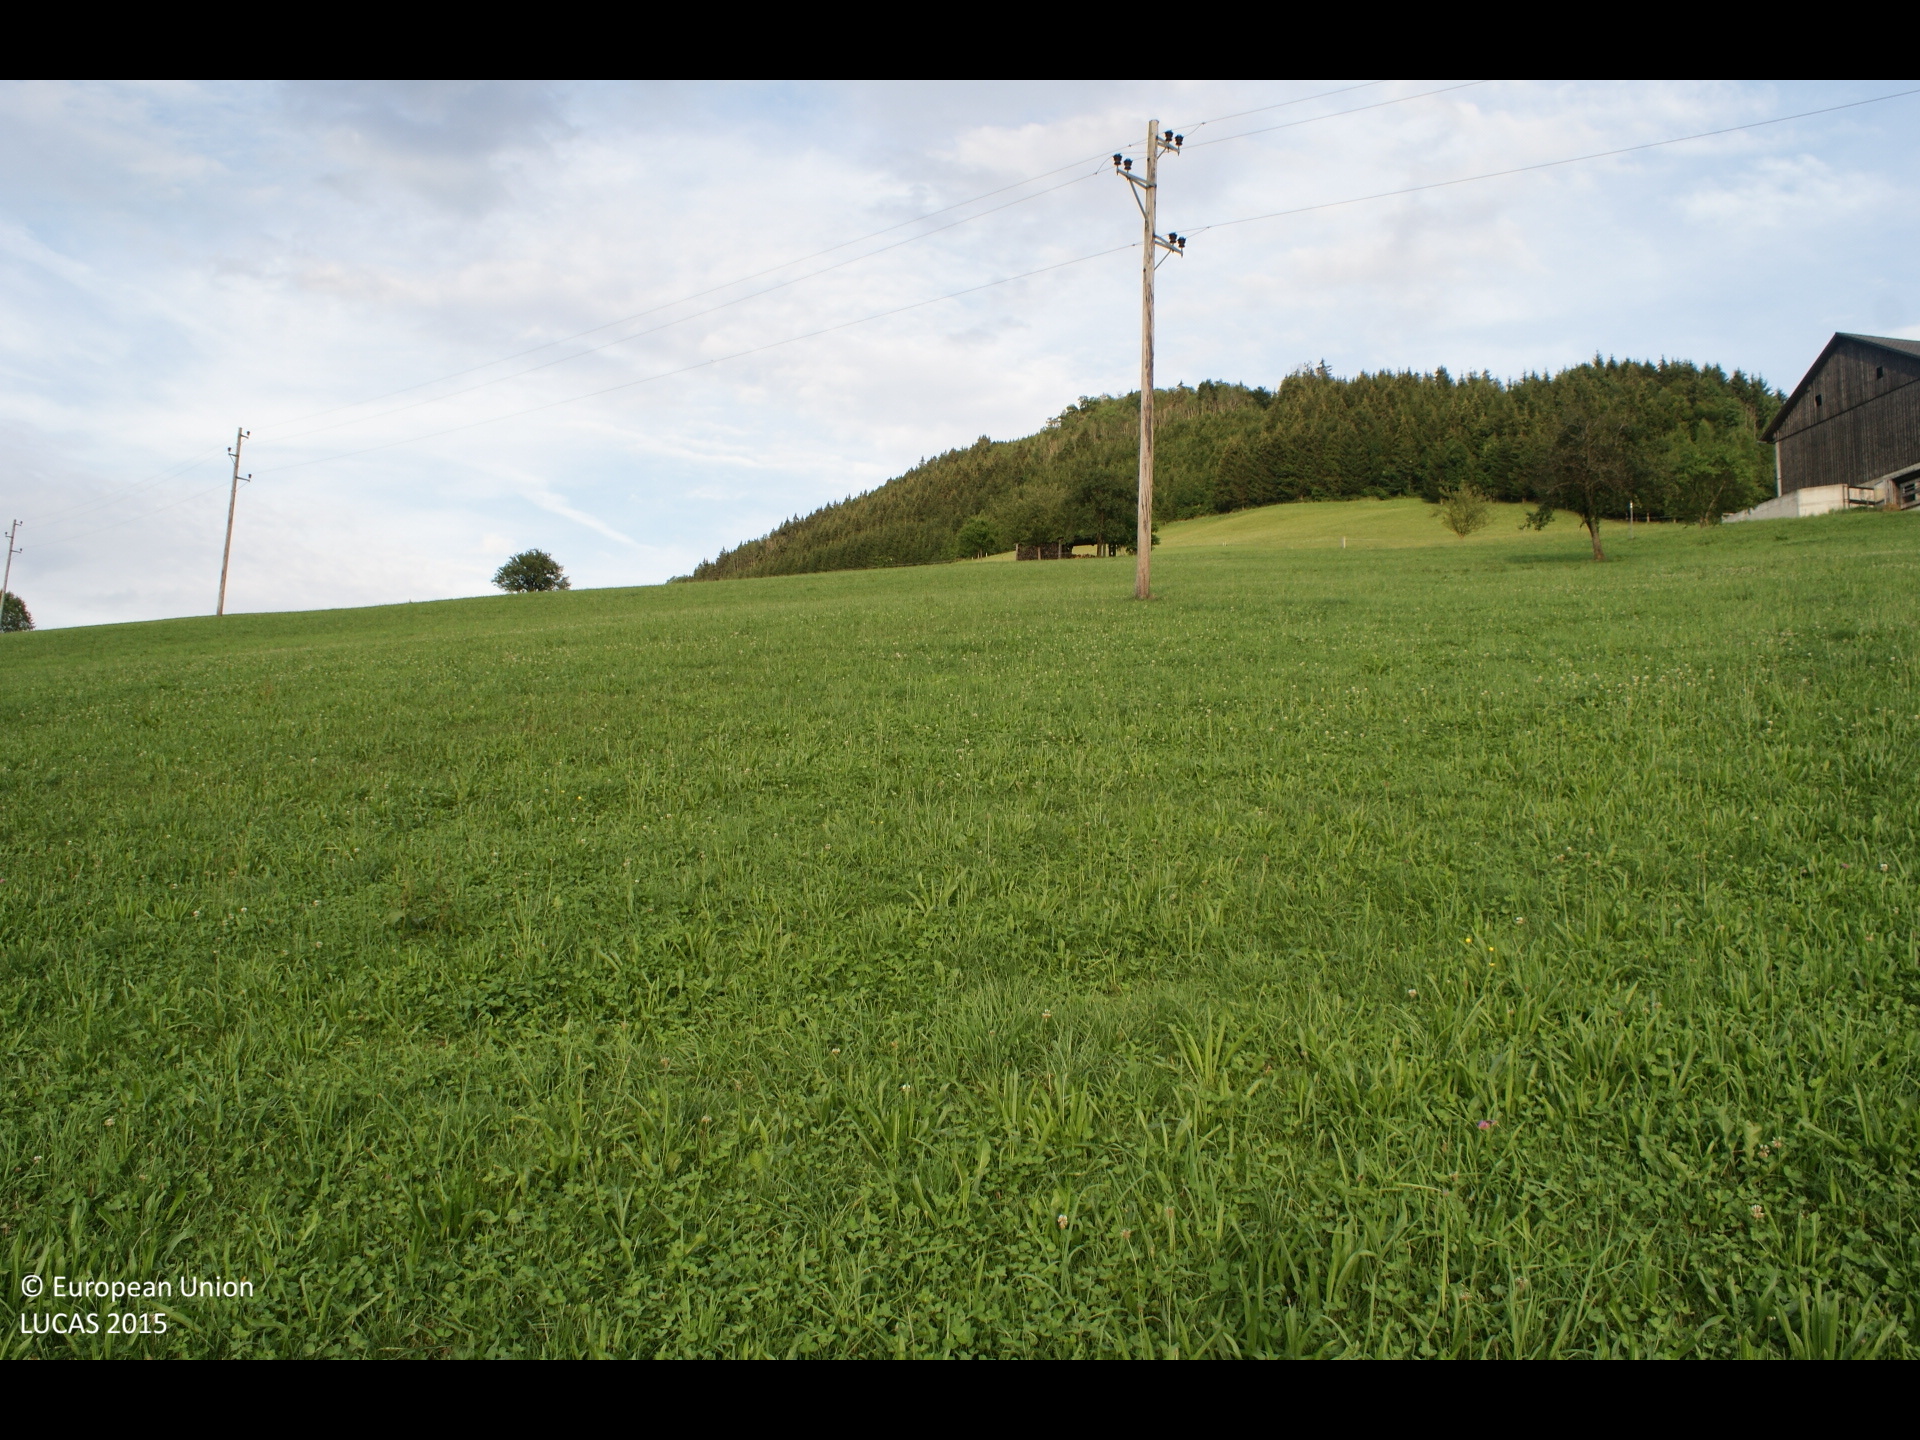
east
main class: Grassland
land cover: Grassland without tree/shrub cover
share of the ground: > 75 %
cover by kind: herbaceous plants 100 %
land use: Agriculture (excluding fallow land and kitchen gardens)
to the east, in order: Grassland without tree/shrub cover; Electric lines; Grassland without tree/shrub cover; Paved roads, cycling and walking lanes; Grassland without tree/shrub cover; Fences; Tracks; Grassland without tree/shrub cover
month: July
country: AT
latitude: 47.9493
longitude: 14.9682
